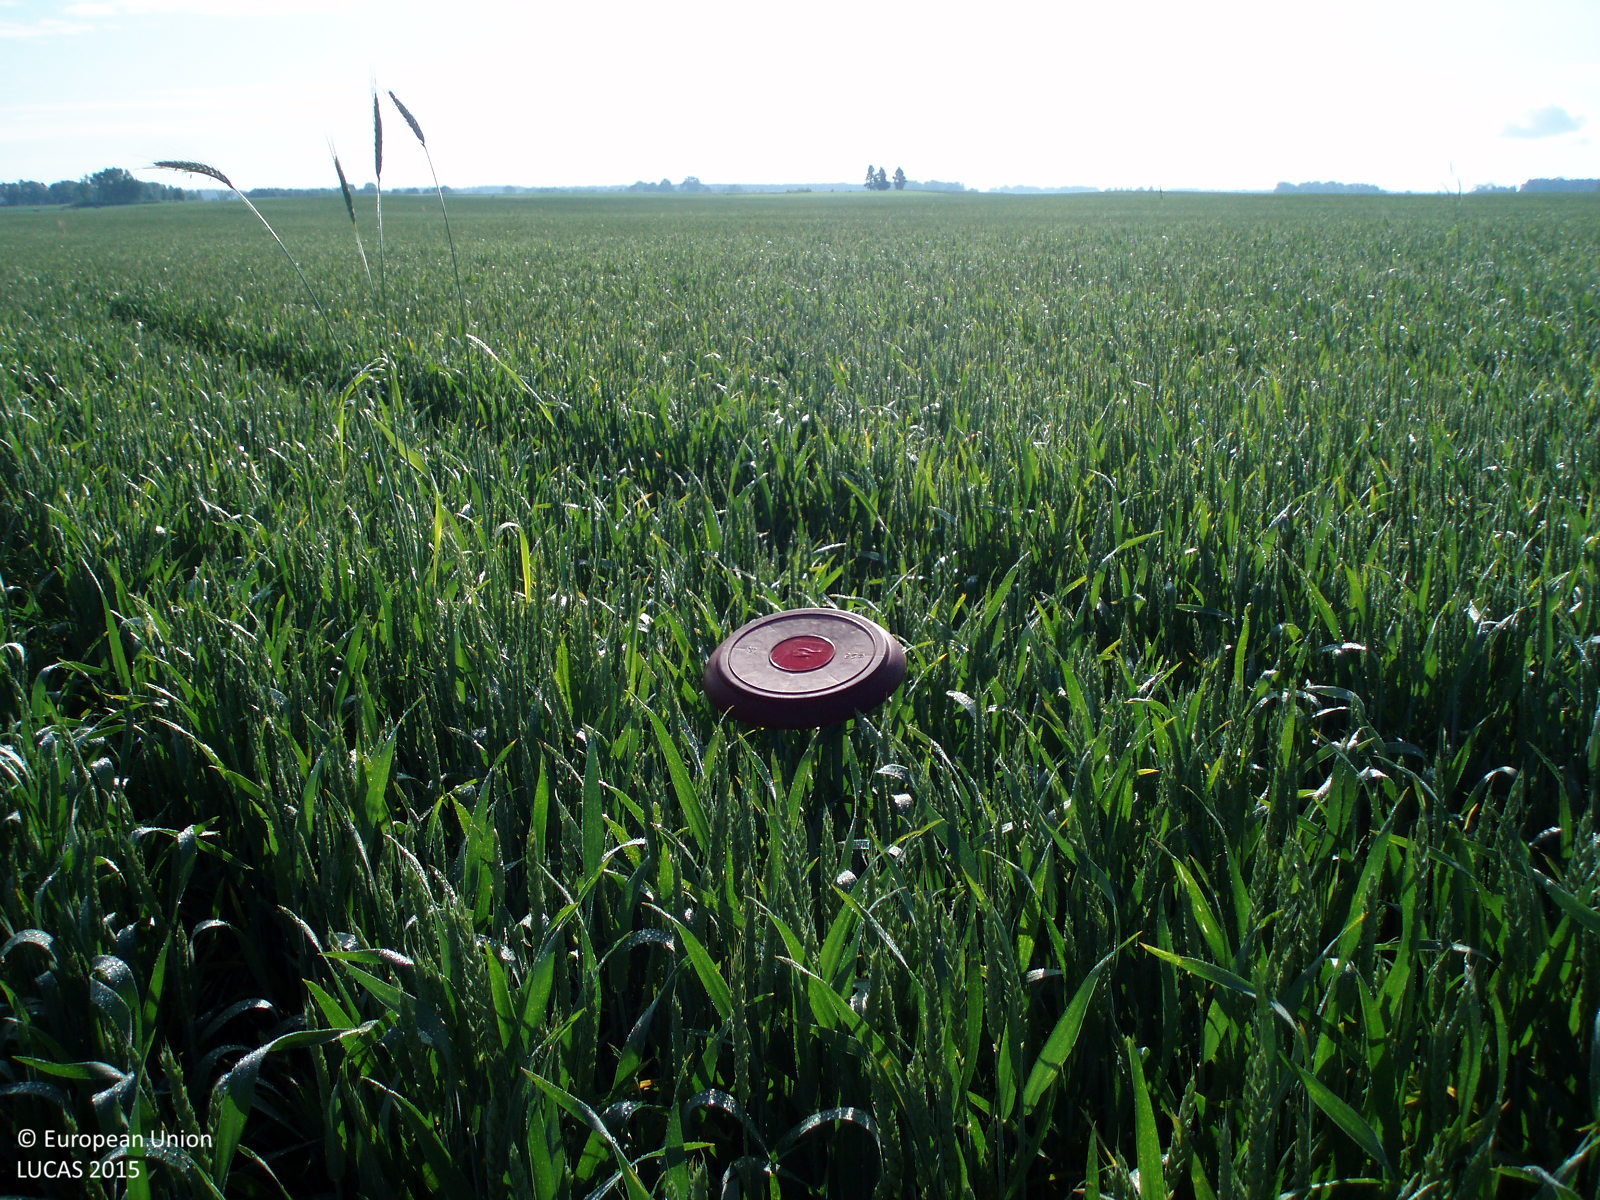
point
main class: Cropland
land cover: Common wheat
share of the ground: > 75 %
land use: Agriculture (excluding fallow land and kitchen gardens)
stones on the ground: < 10 %
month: June
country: LT
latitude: 56.3467
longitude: 23.3239
